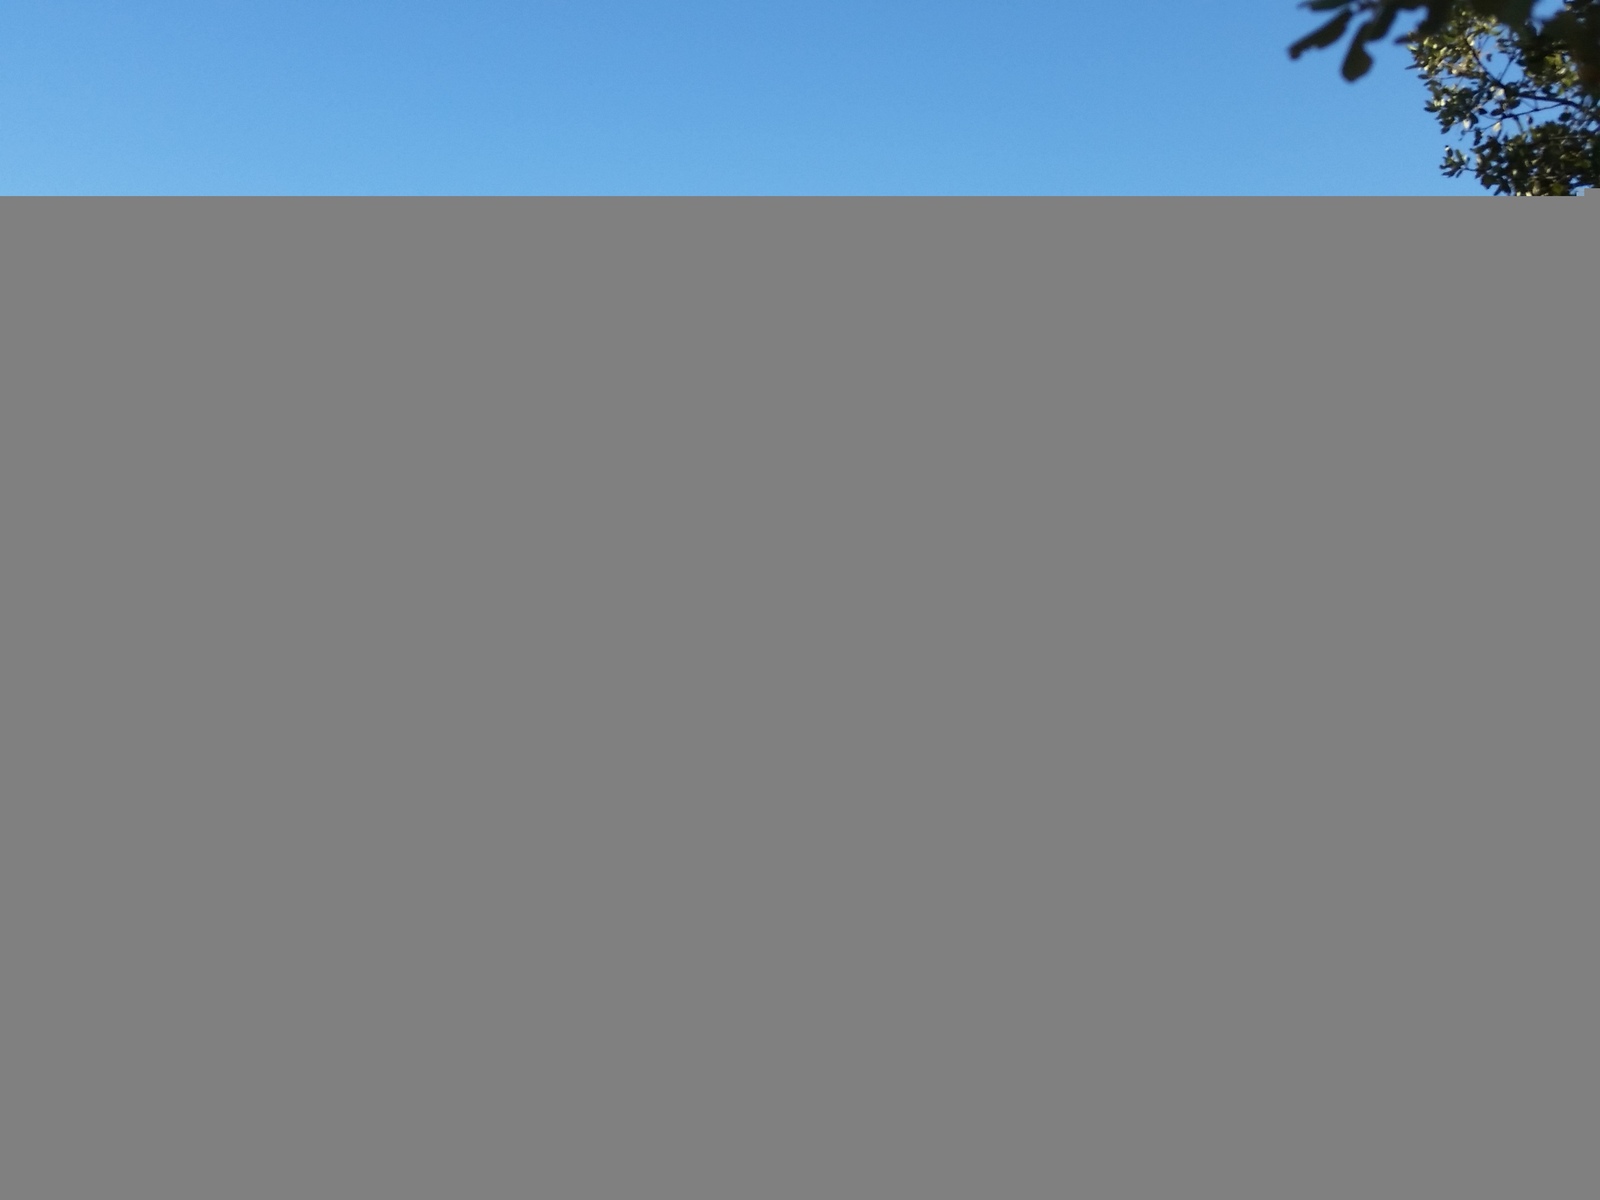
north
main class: Shrubland
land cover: Shrubland with sparse tree cover
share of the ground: > 75 %
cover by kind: shrubs 60 %, consolidated bare surface 25 %, herbaceous plants 10 %, broadleaved forest trees 5 %
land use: Semi-natural and natural areas not in use
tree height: < 5 m
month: July
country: ES
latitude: 38.9878
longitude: -2.5085
